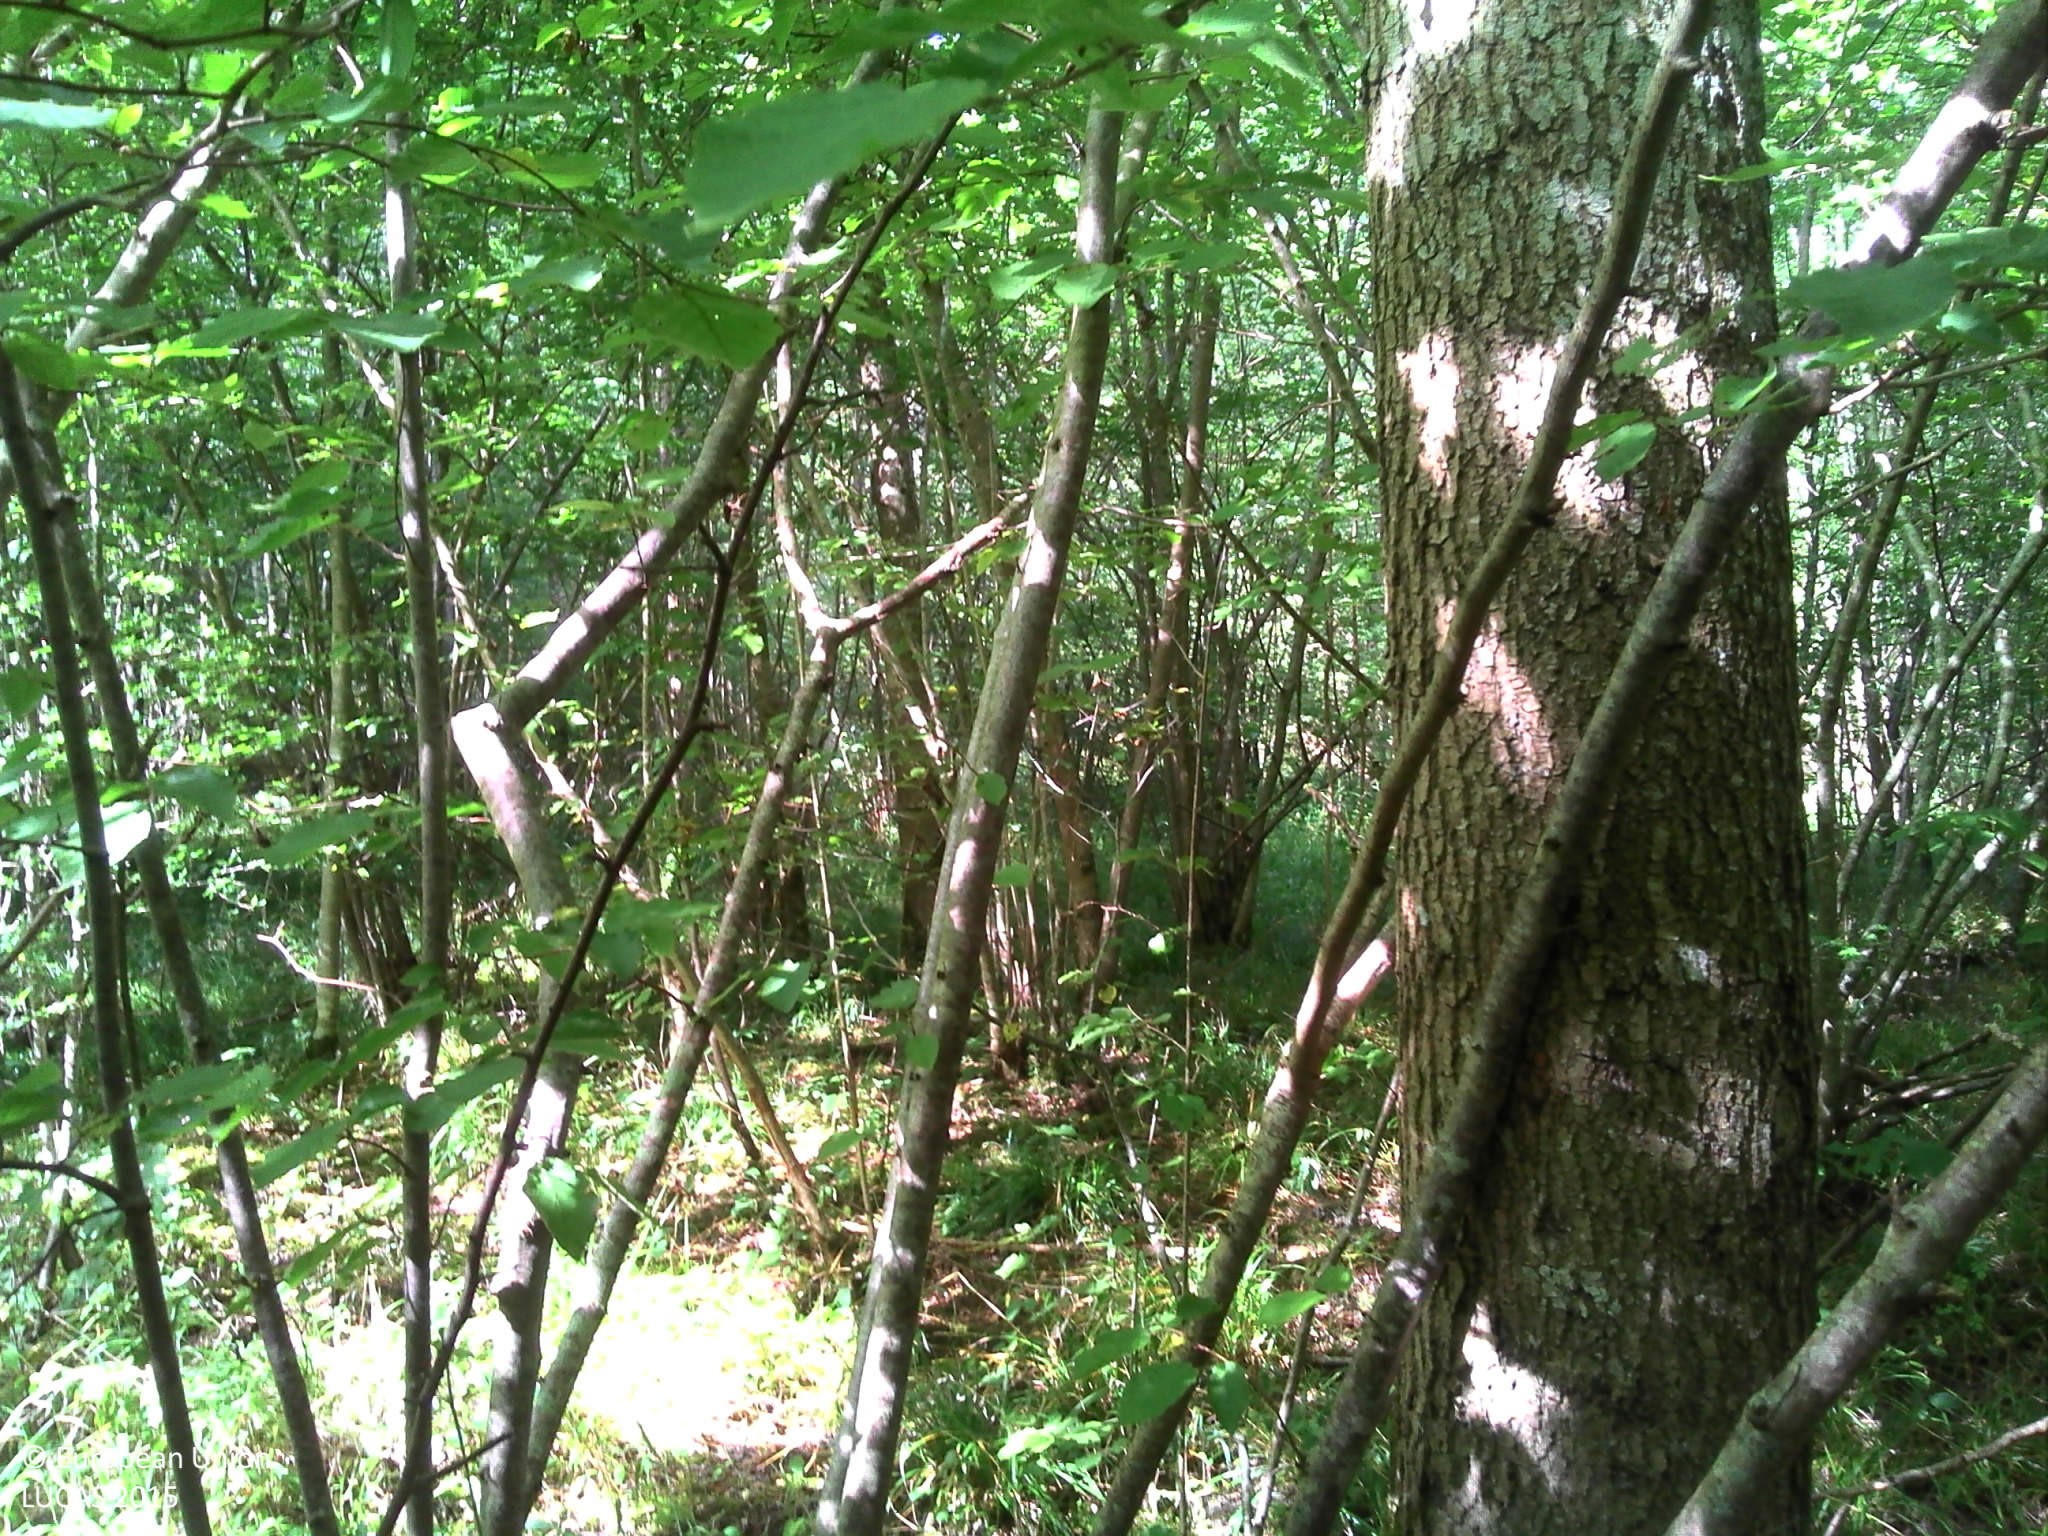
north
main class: Woodland
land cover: Broadleaved woodland
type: mesophytic deciduous forest
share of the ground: > 75 %
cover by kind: broadleaved forest trees 50 %, herbaceous plants 15 %, lichens and mosses 15 %, unconsolidated bare surface 10 %
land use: Forestry
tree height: > 5 m
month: July
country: FR
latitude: 48.7769
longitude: 2.7097
